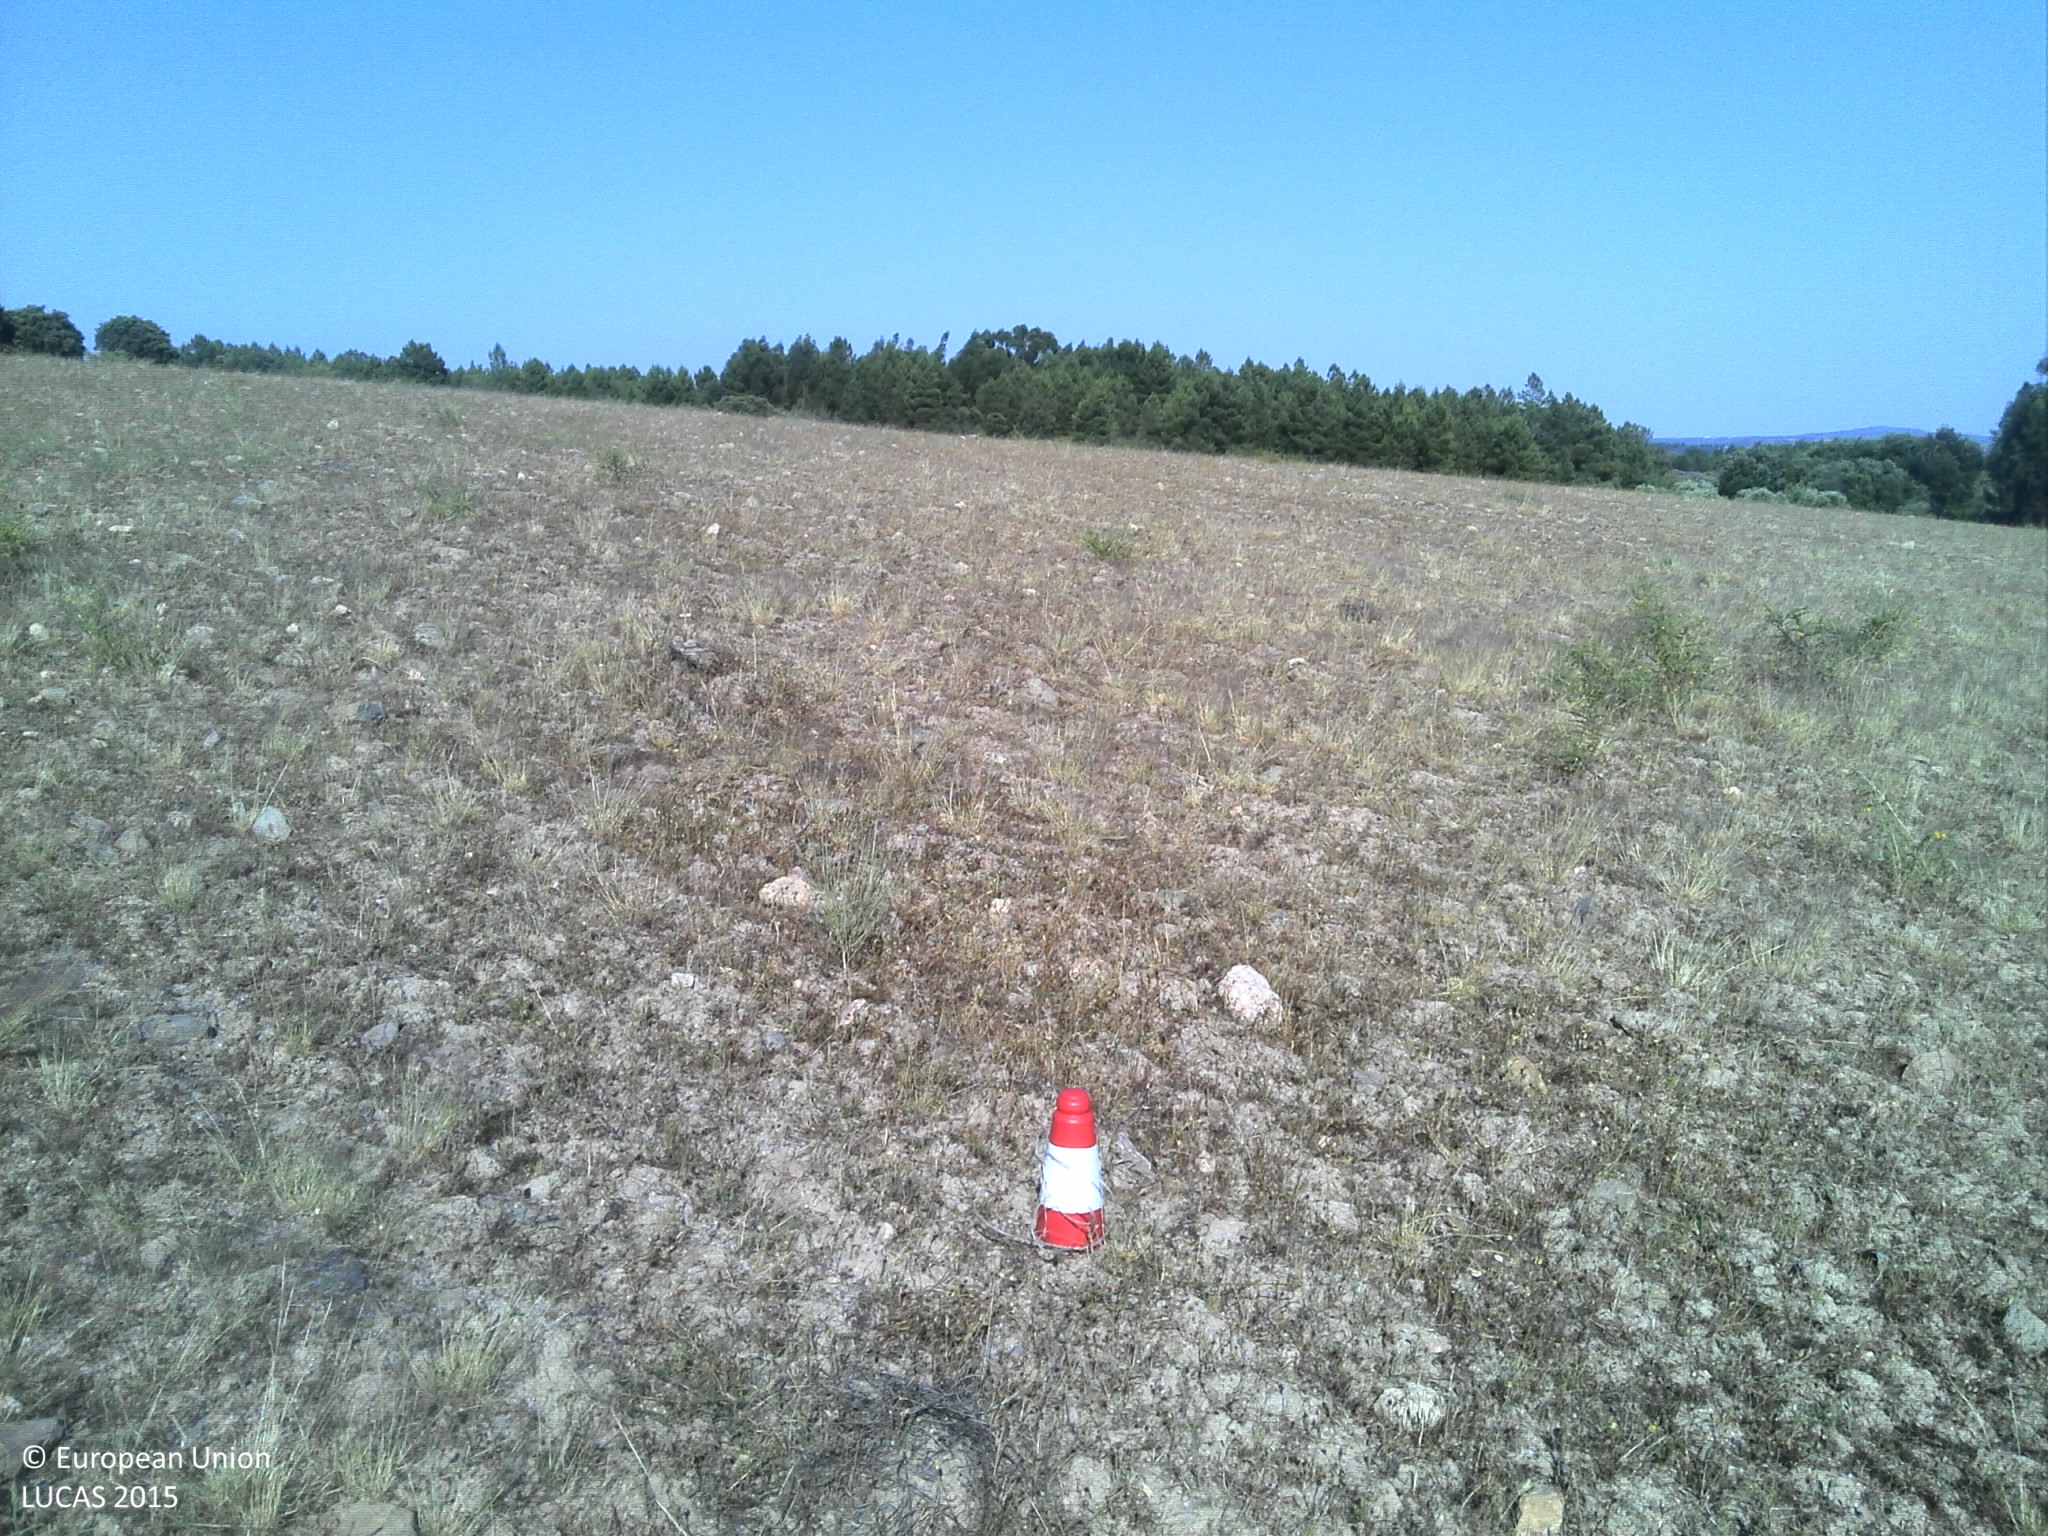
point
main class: Grassland
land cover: Spontaneously vegetated surfaces
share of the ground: 10 - 25 %
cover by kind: unconsolidated bare surface 70 %, herbaceous plants 25 %
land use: Agriculture (excluding fallow land and kitchen gardens)
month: June
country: PT
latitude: 40.0046
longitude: -7.4257
